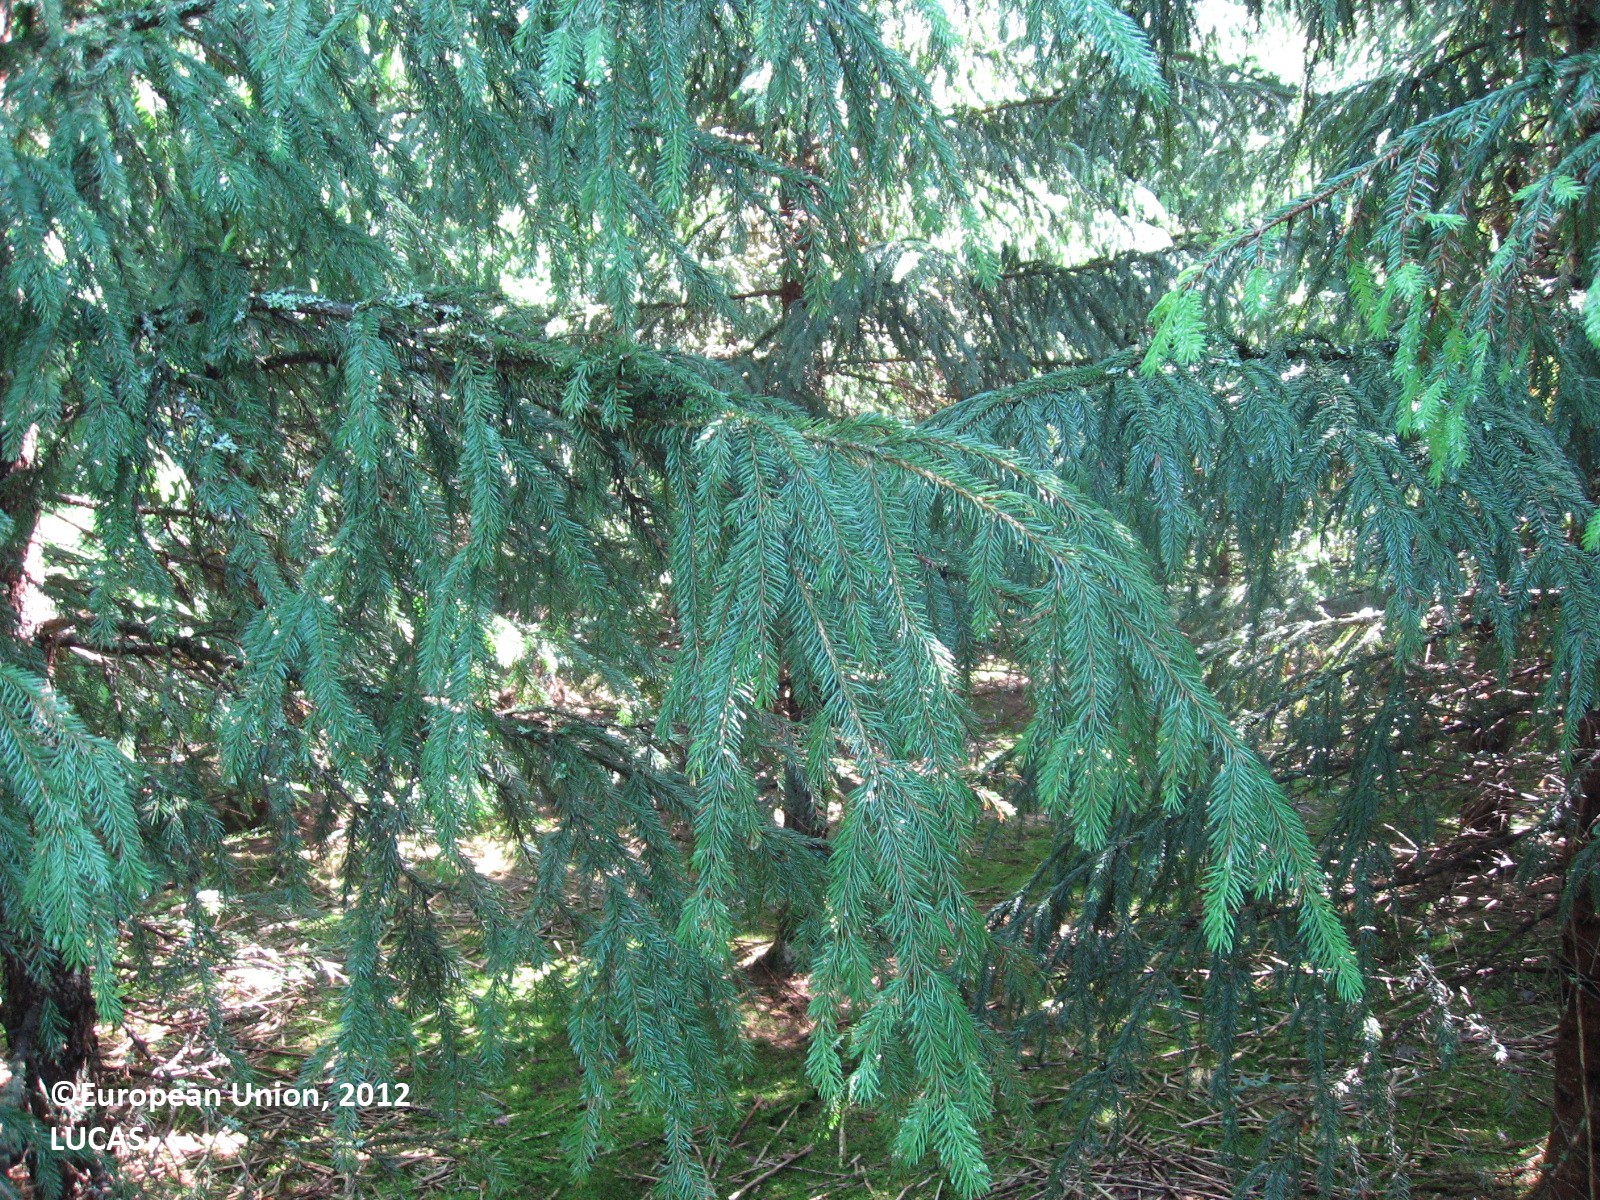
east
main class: Woodland
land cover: Spruce dominated coniferous woodland
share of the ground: > 75 %
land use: Forestry
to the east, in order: Spruce dominated coniferous woodland; Spruce dominated mixed woodland; Ditches and canals; Spruce dominated mixed woodland; Ditches and canals; Spruce dominated mixed woodland
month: June
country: FI
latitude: 60.5357
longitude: 26.4292
